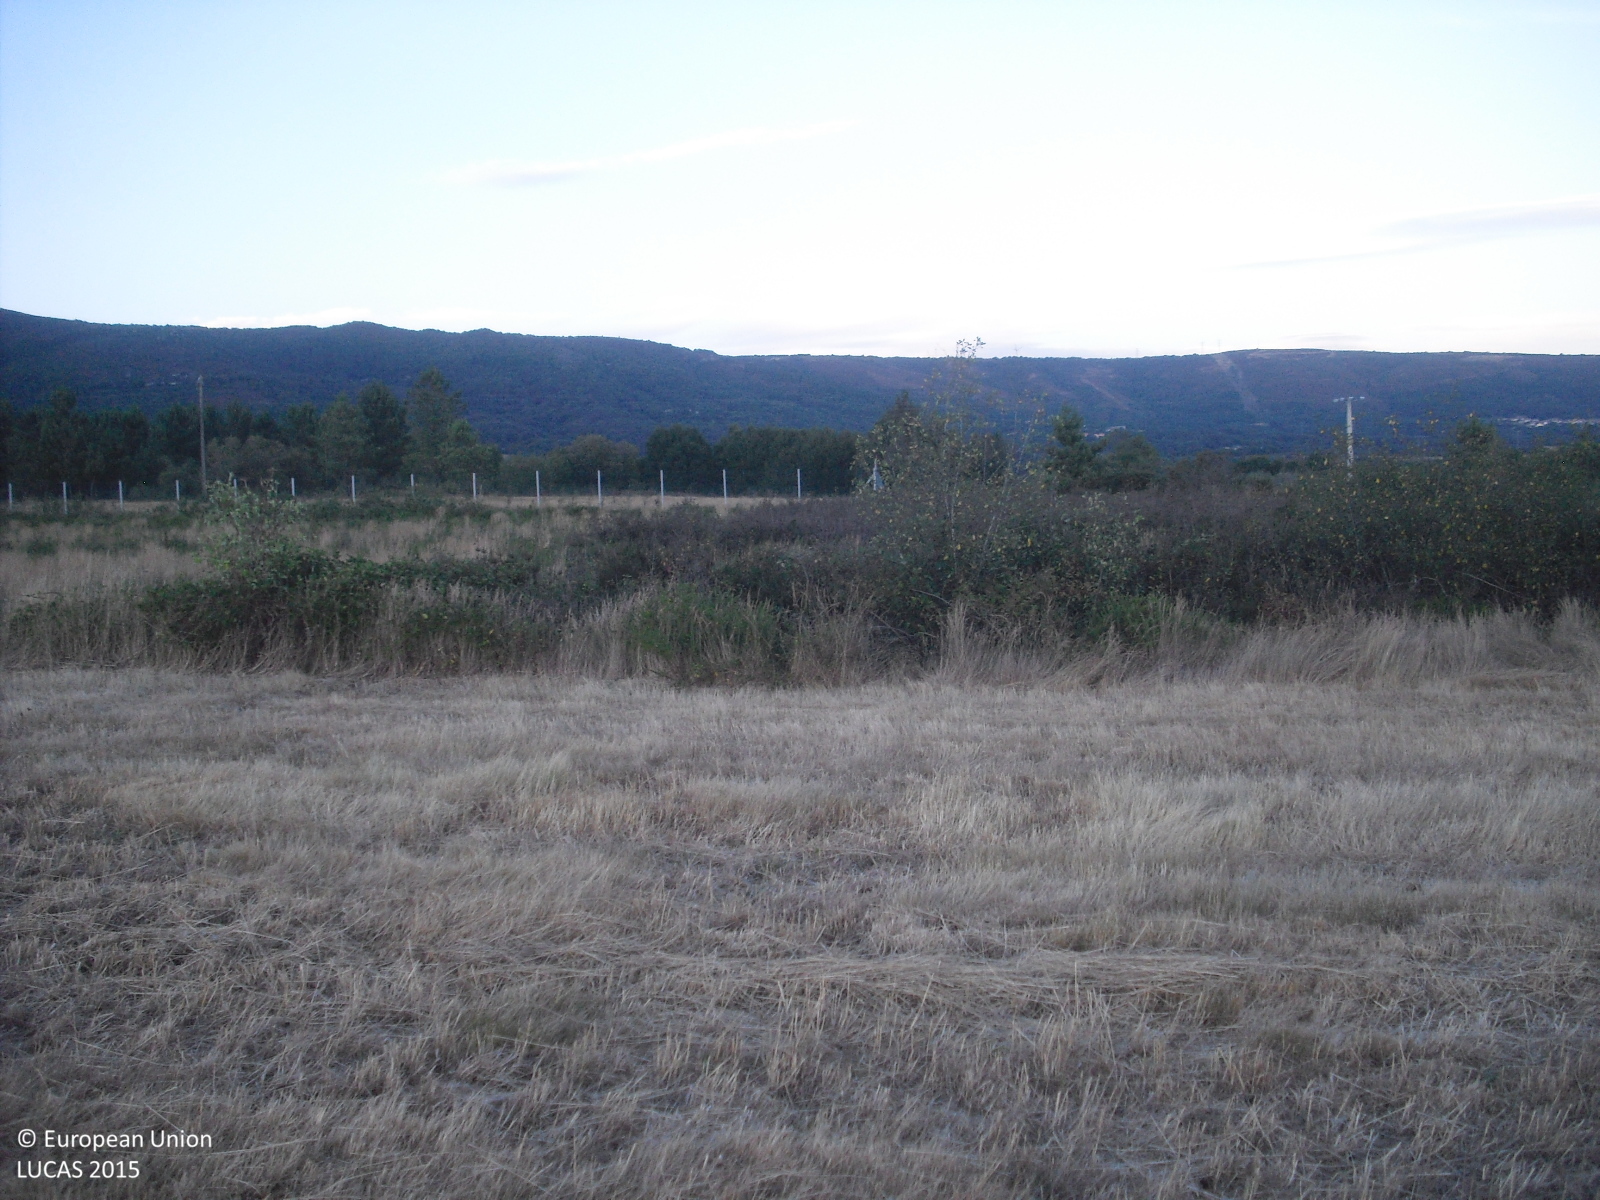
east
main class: Cropland
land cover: Temporary grasslands
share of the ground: > 75 %
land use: Agriculture (excluding fallow land and kitchen gardens)
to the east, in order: Temporary grasslands; Abandoned hedges; Shrubland without tree cover; Ditches and canals; Shruby margins; Paved roads, cycling and walking lanes; Shruby margins; Ditches and canals; Shrubland without tree cover; Electric lines; Shrubland without tree cover; Broadleaved woodland
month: July
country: ES
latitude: 42.2893
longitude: -7.6436
